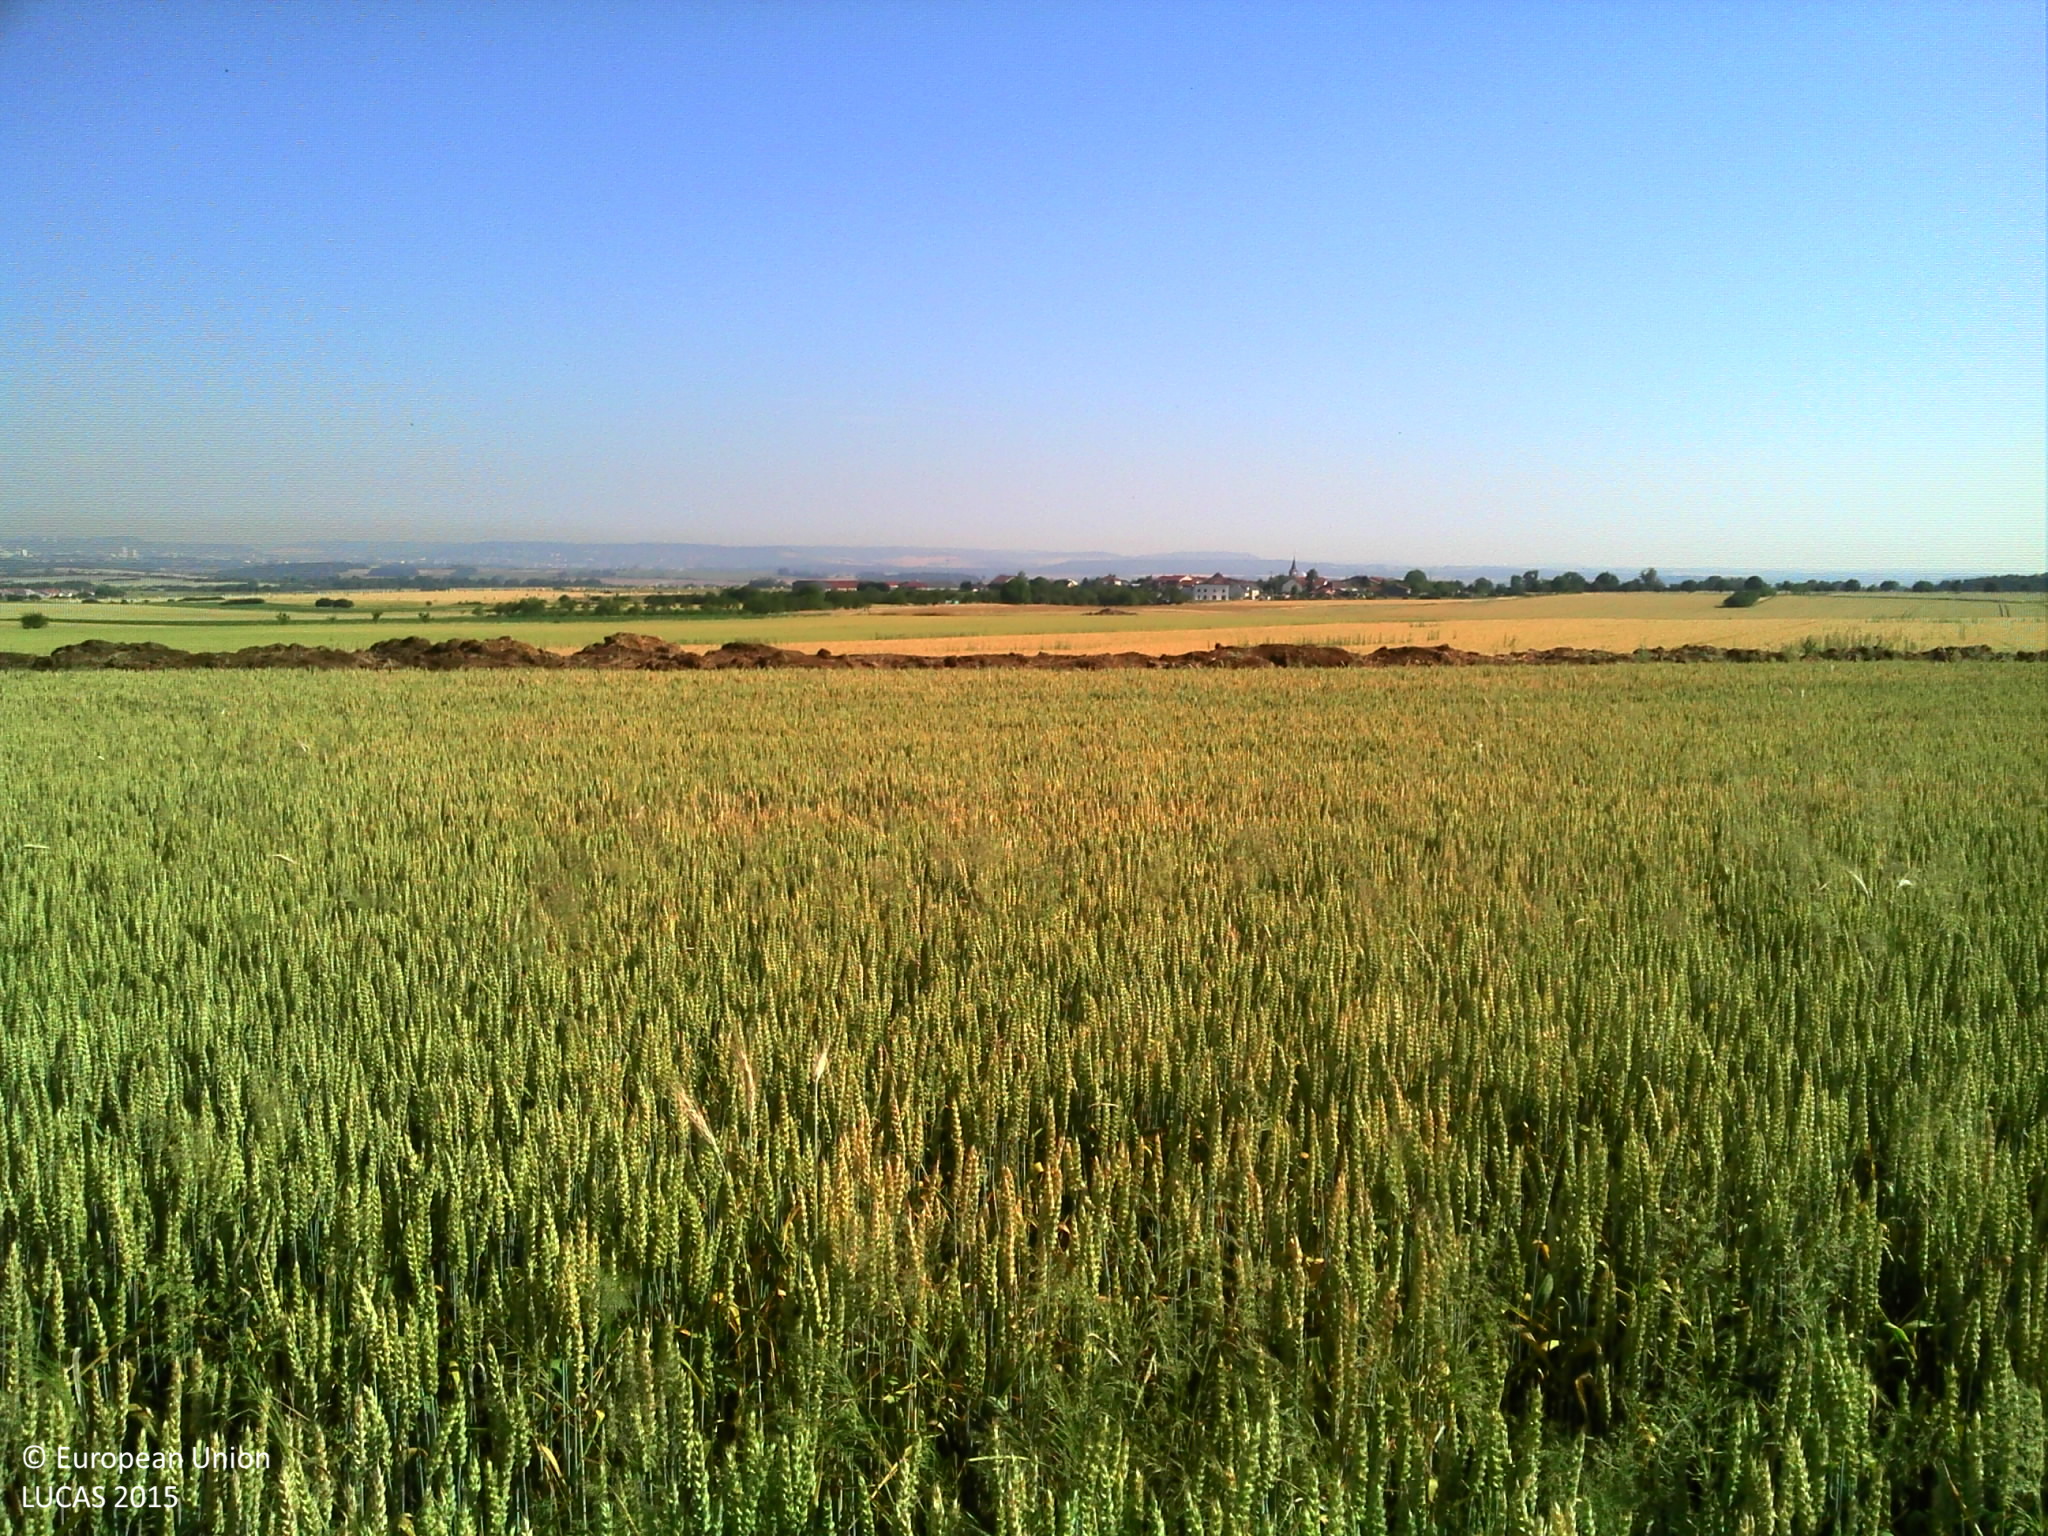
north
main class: Cropland
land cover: Common wheat
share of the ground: > 75 %
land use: Agriculture (excluding fallow land and kitchen gardens)
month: July
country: FR
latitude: 48.5739
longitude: 6.2459
